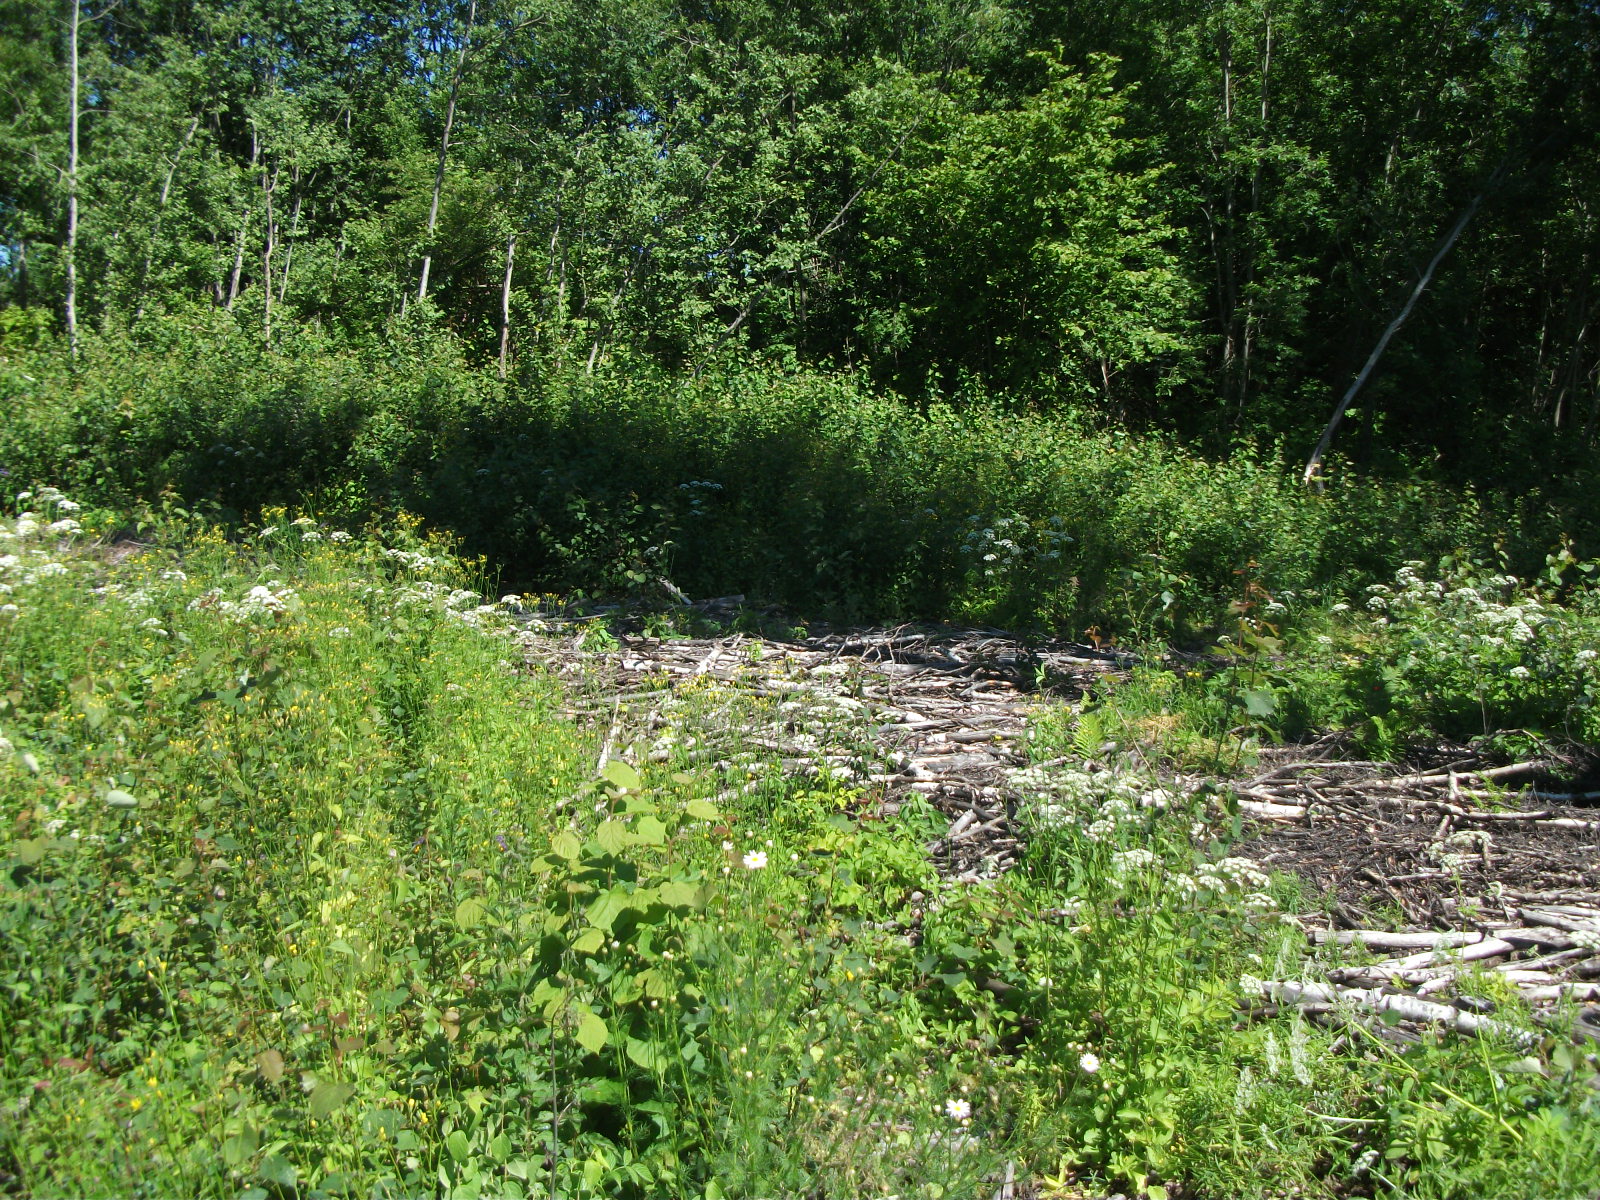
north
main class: Woodland
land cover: Broadleaved woodland
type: non-riverine alder, birch or aspen forest
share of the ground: 25 - 50 %
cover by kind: herbaceous plants 40 %, broadleaved forest trees 30 %, shrubs 25 %, lichens and mosses 5 %
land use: Forestry
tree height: < 5 m
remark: Clear cut
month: July
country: LV
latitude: 56.7894
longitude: 26.1632
